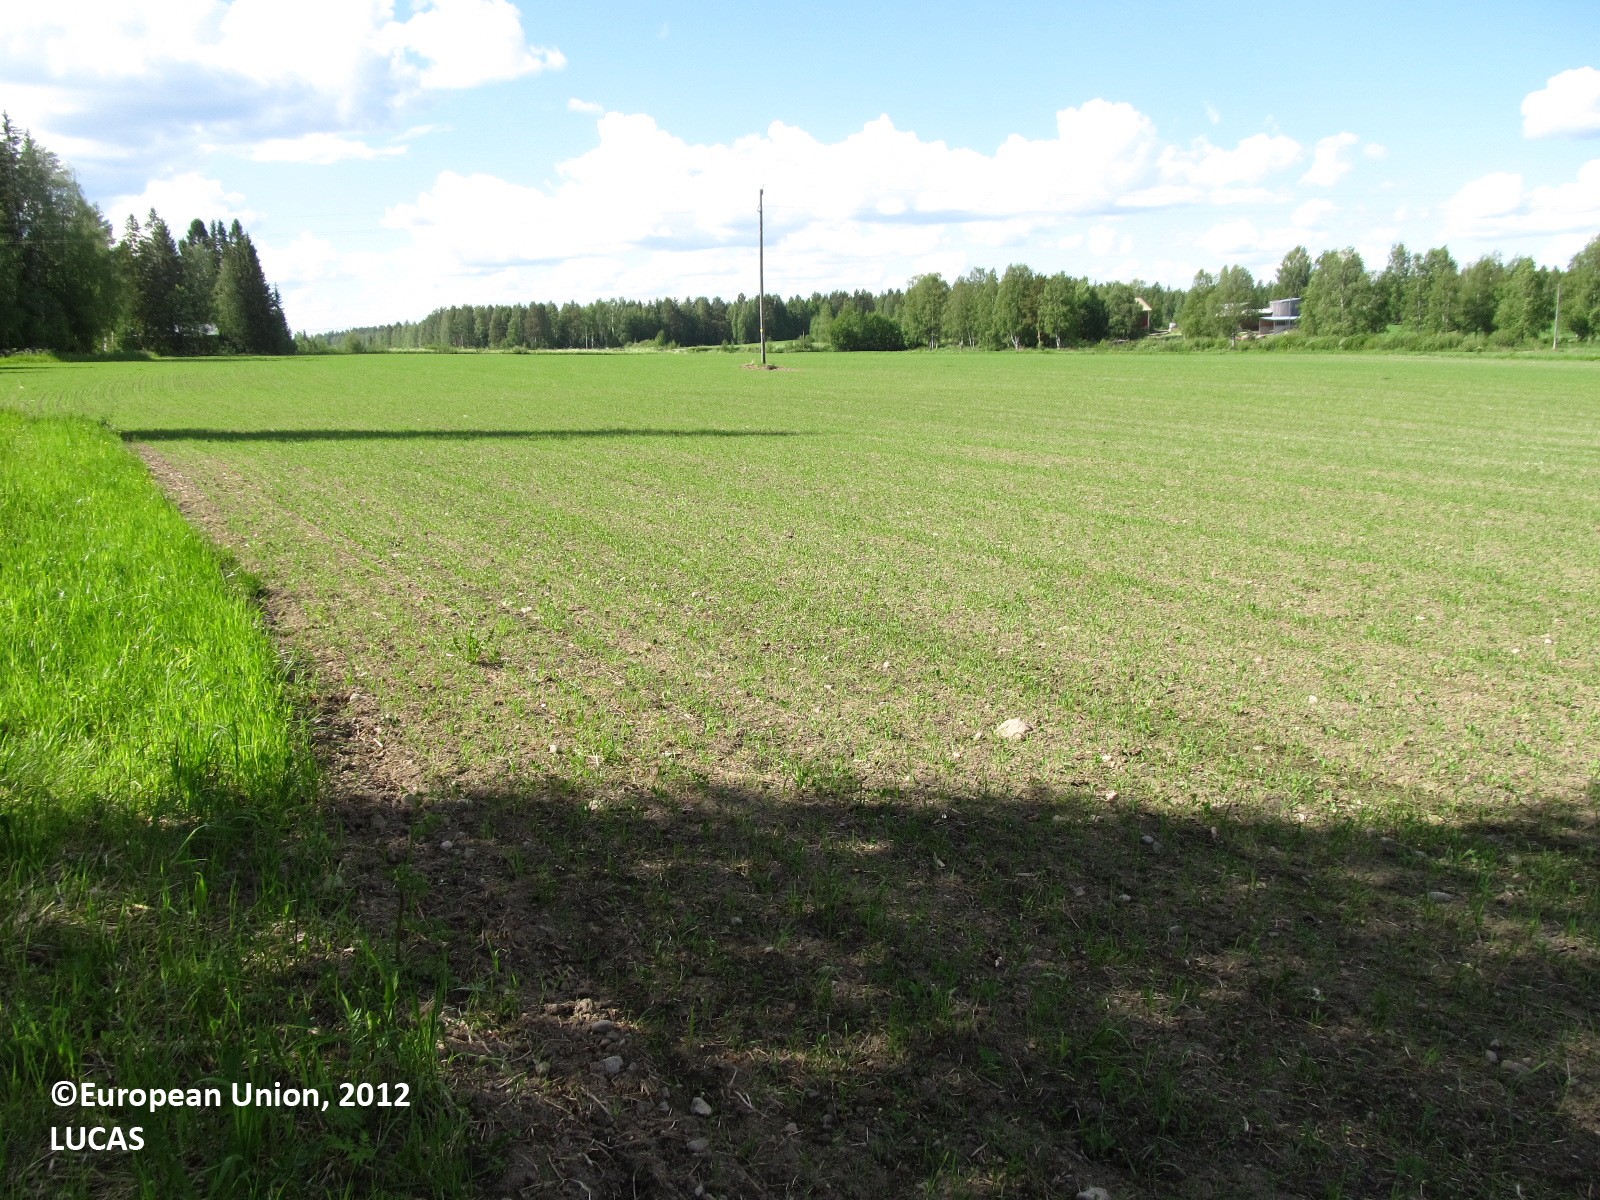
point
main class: Cropland
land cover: Temporary grasslands
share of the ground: 10 - 25 %
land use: Agriculture (excluding fallow land and kitchen gardens)
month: June
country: FI
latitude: 62.7406
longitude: 27.6860
